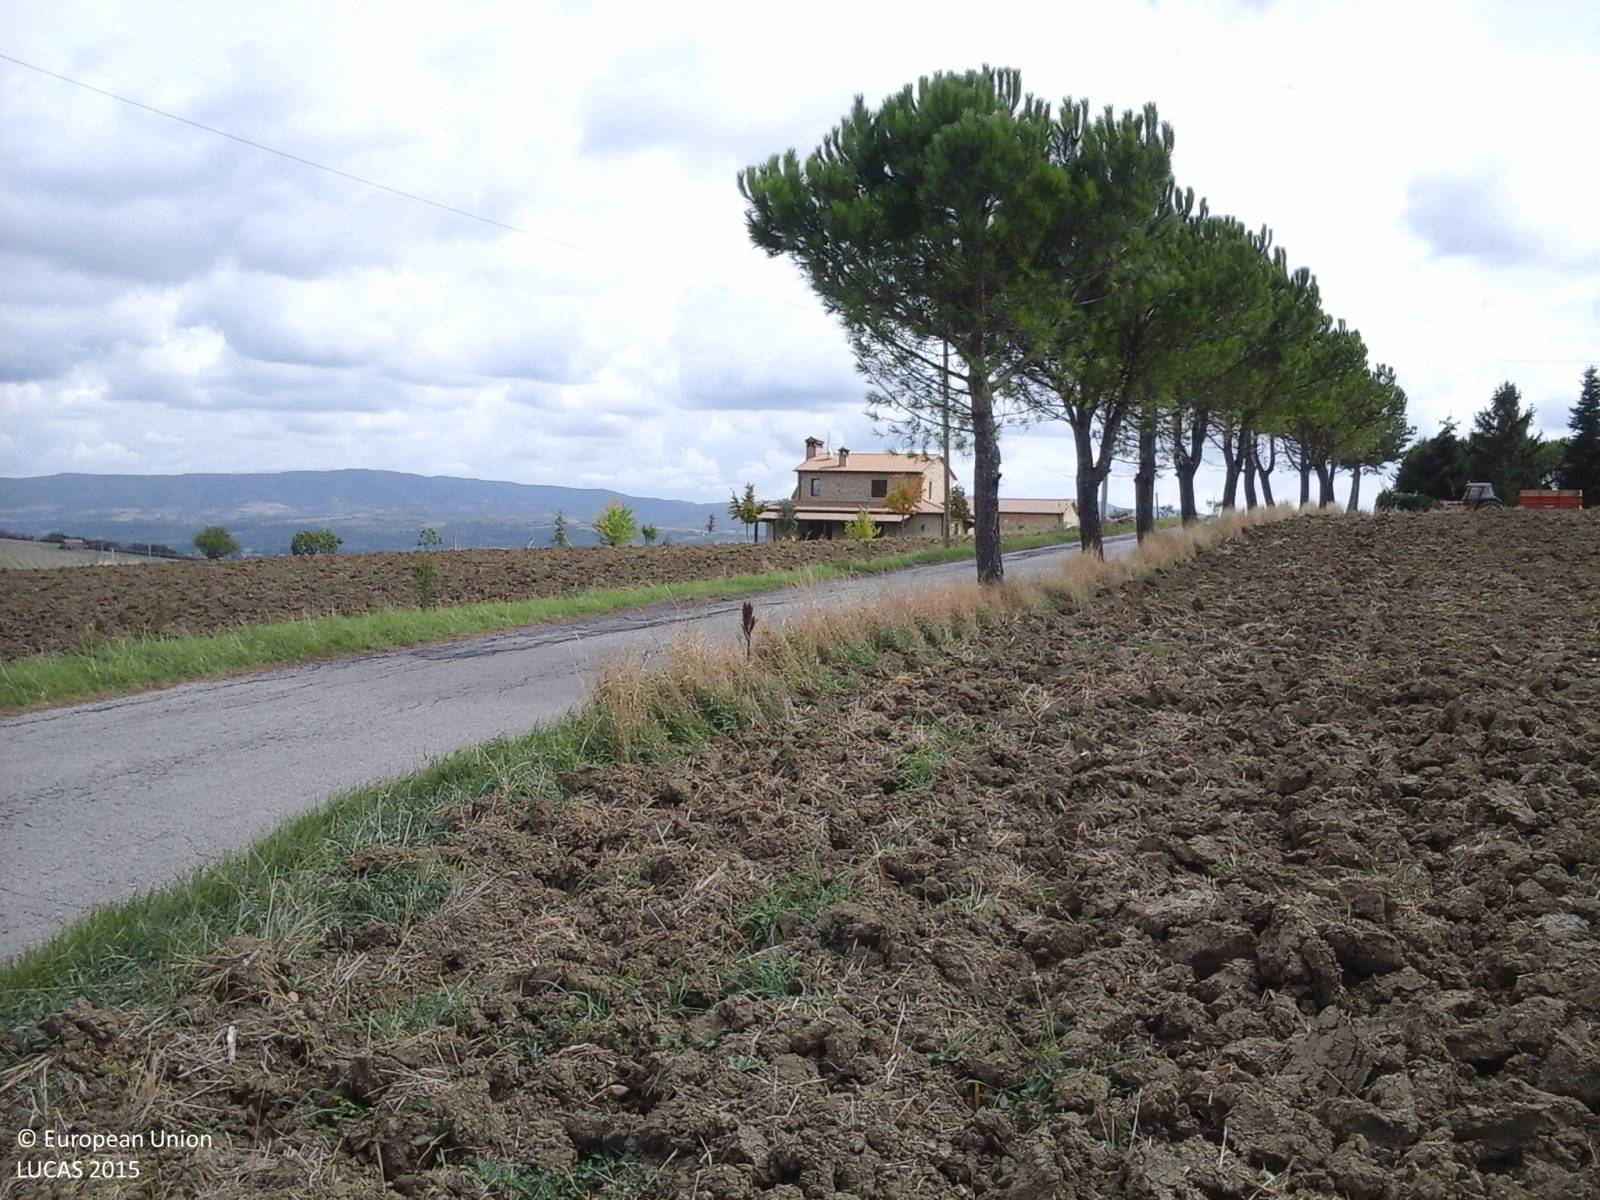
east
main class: Cropland
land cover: Barley
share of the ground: < 10 %
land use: Agriculture (excluding fallow land and kitchen gardens)
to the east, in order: Barley; Grass margins; Ditches and canals; Lines of trees; Paved roads, cycling and walking lanes; Grass margins; Ditches and canals; Electric lines; Grassland with sparse tree/shrub cover; Artificial constructions in urban areas; Grassland with sparse tree/shrub cover; Tracks; Grass margins; Ditches and canals; Barley
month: September
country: IT
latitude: 42.9343
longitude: 12.3334
